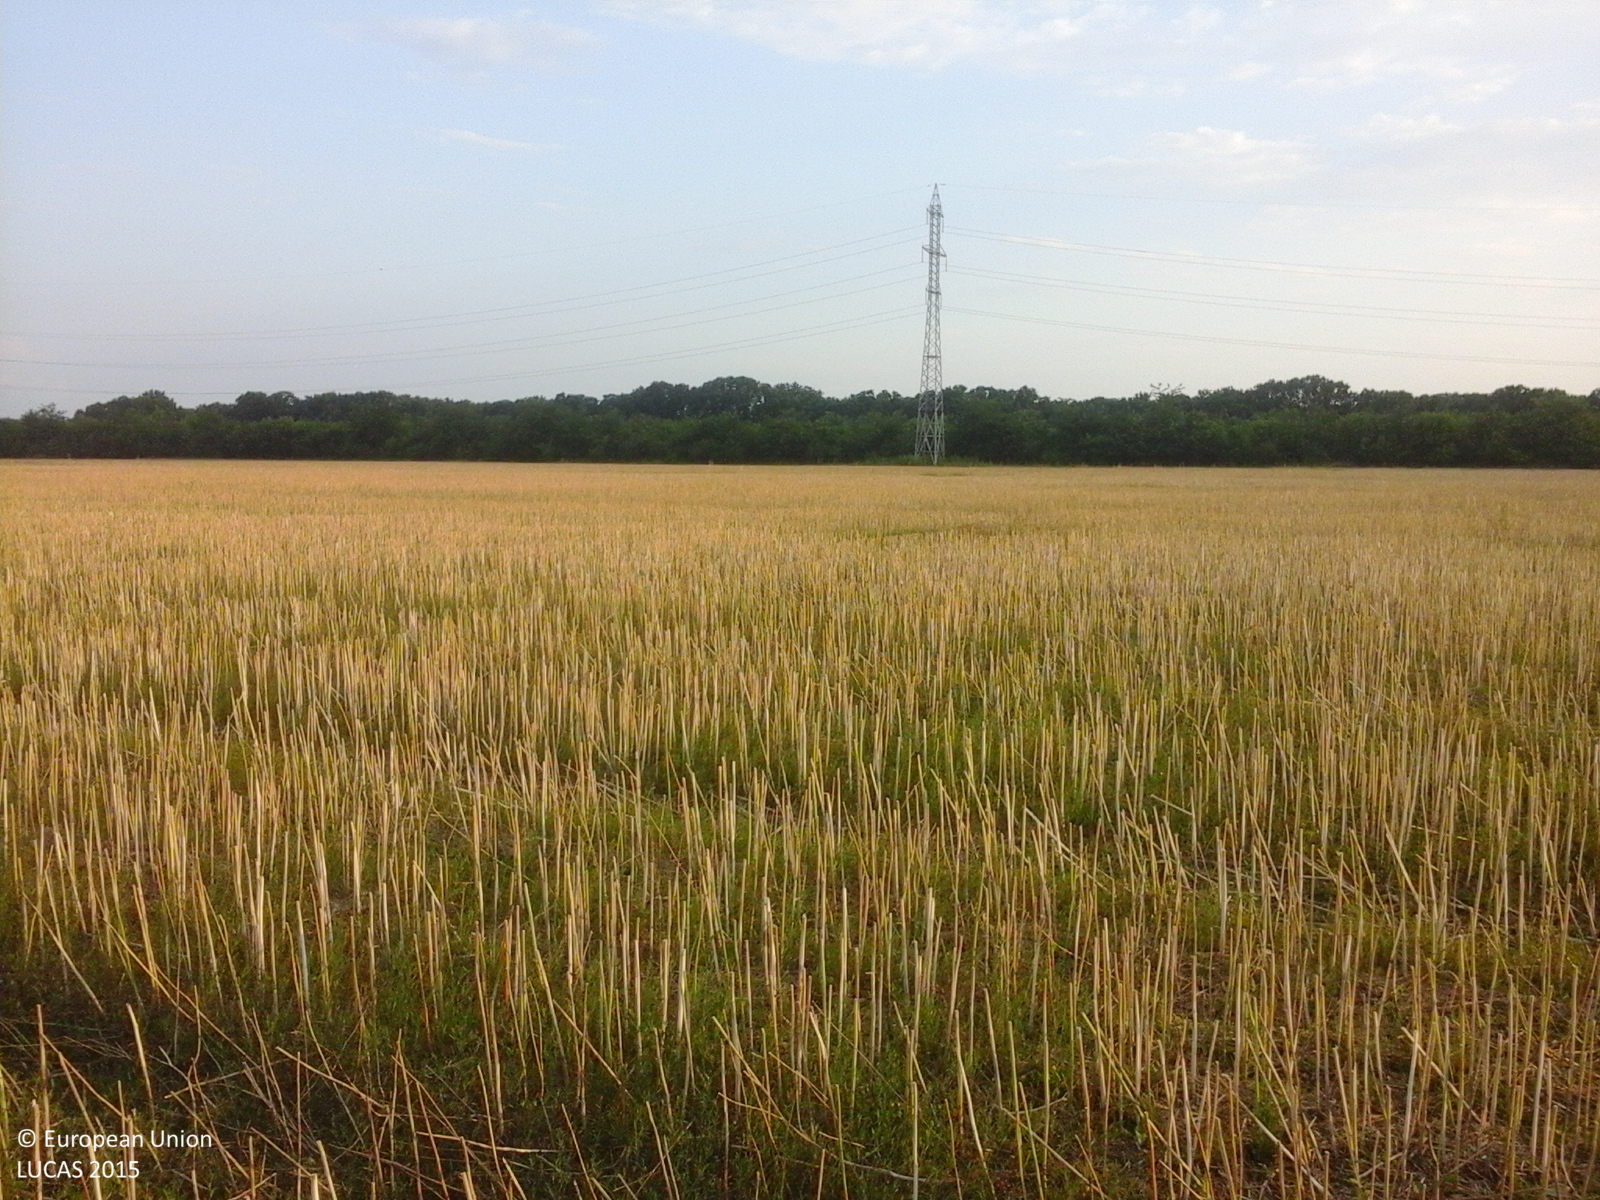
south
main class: Cropland
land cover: Rape and turnip rape
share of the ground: < 10 %
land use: Agriculture (excluding fallow land and kitchen gardens)
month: July
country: RO
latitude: 44.0774
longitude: 25.6116
